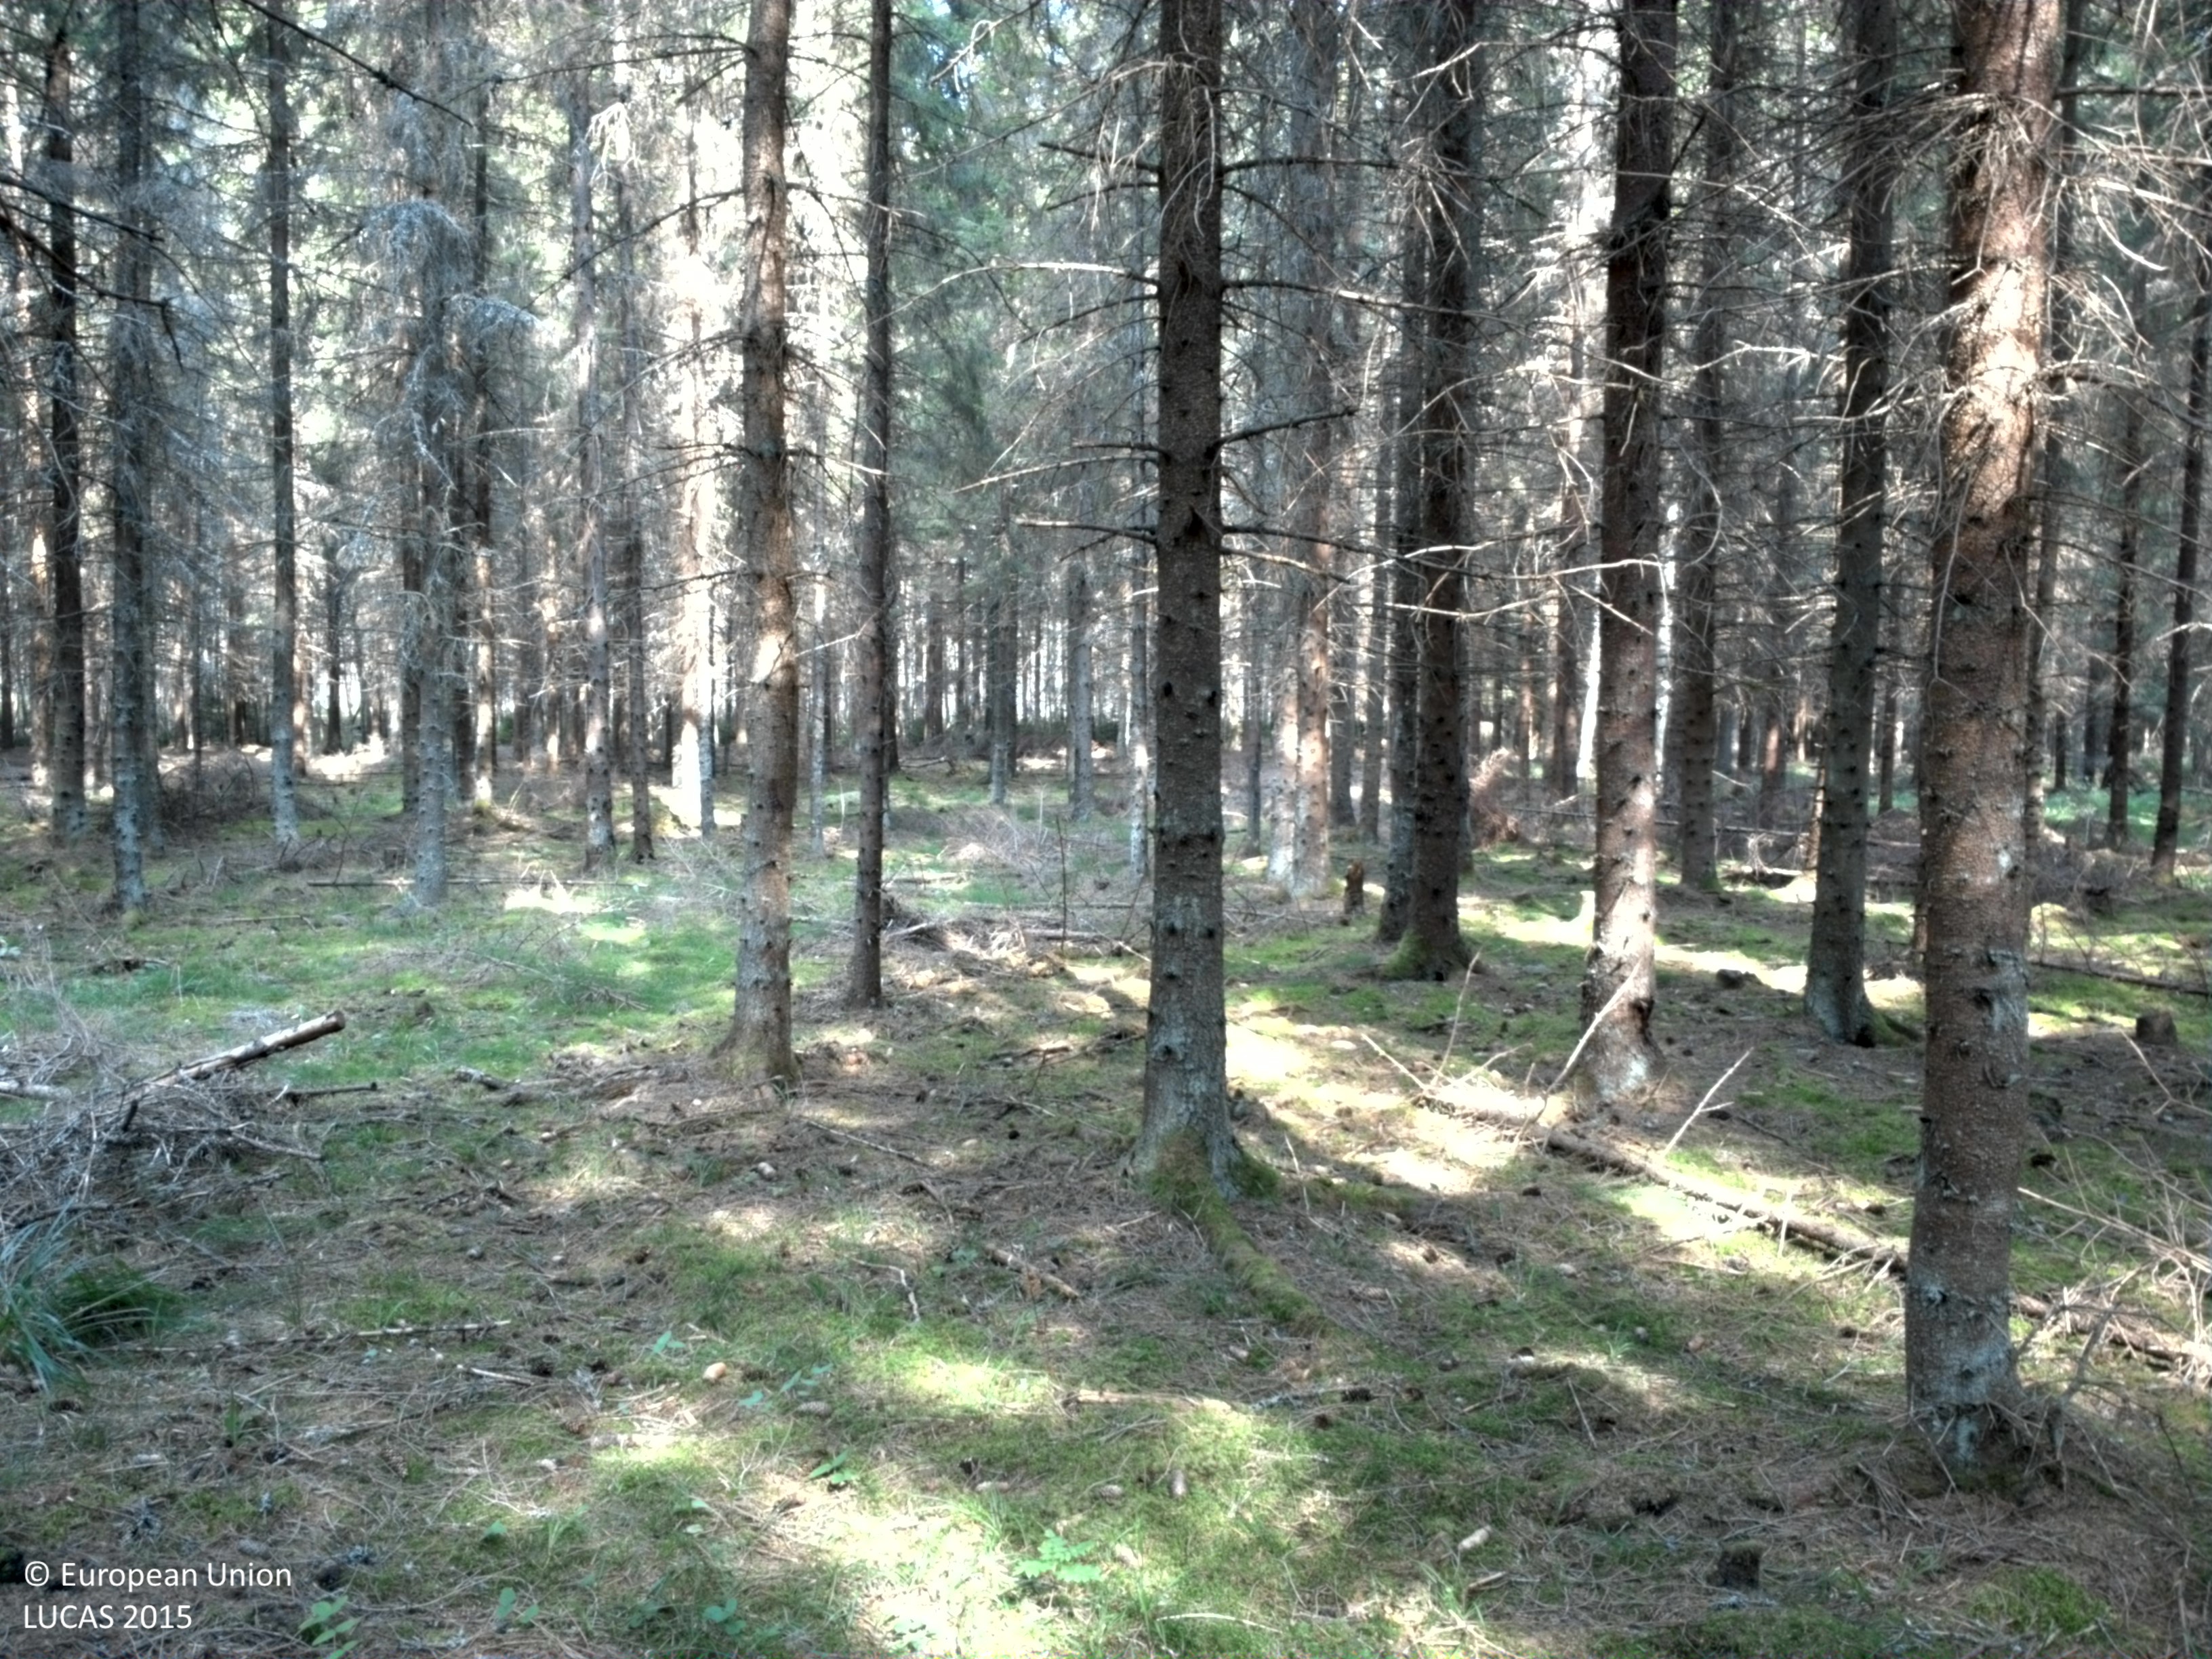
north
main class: Woodland
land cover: Spruce dominated coniferous woodland
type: boreal forest
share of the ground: > 75 %
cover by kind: coniferous forest trees 85 %, lichens and mosses 10 %, herbaceous plants 5 %
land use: Forestry
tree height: > 5 m
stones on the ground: < 10 %
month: August
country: SE
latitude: 60.0703
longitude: 17.5217
